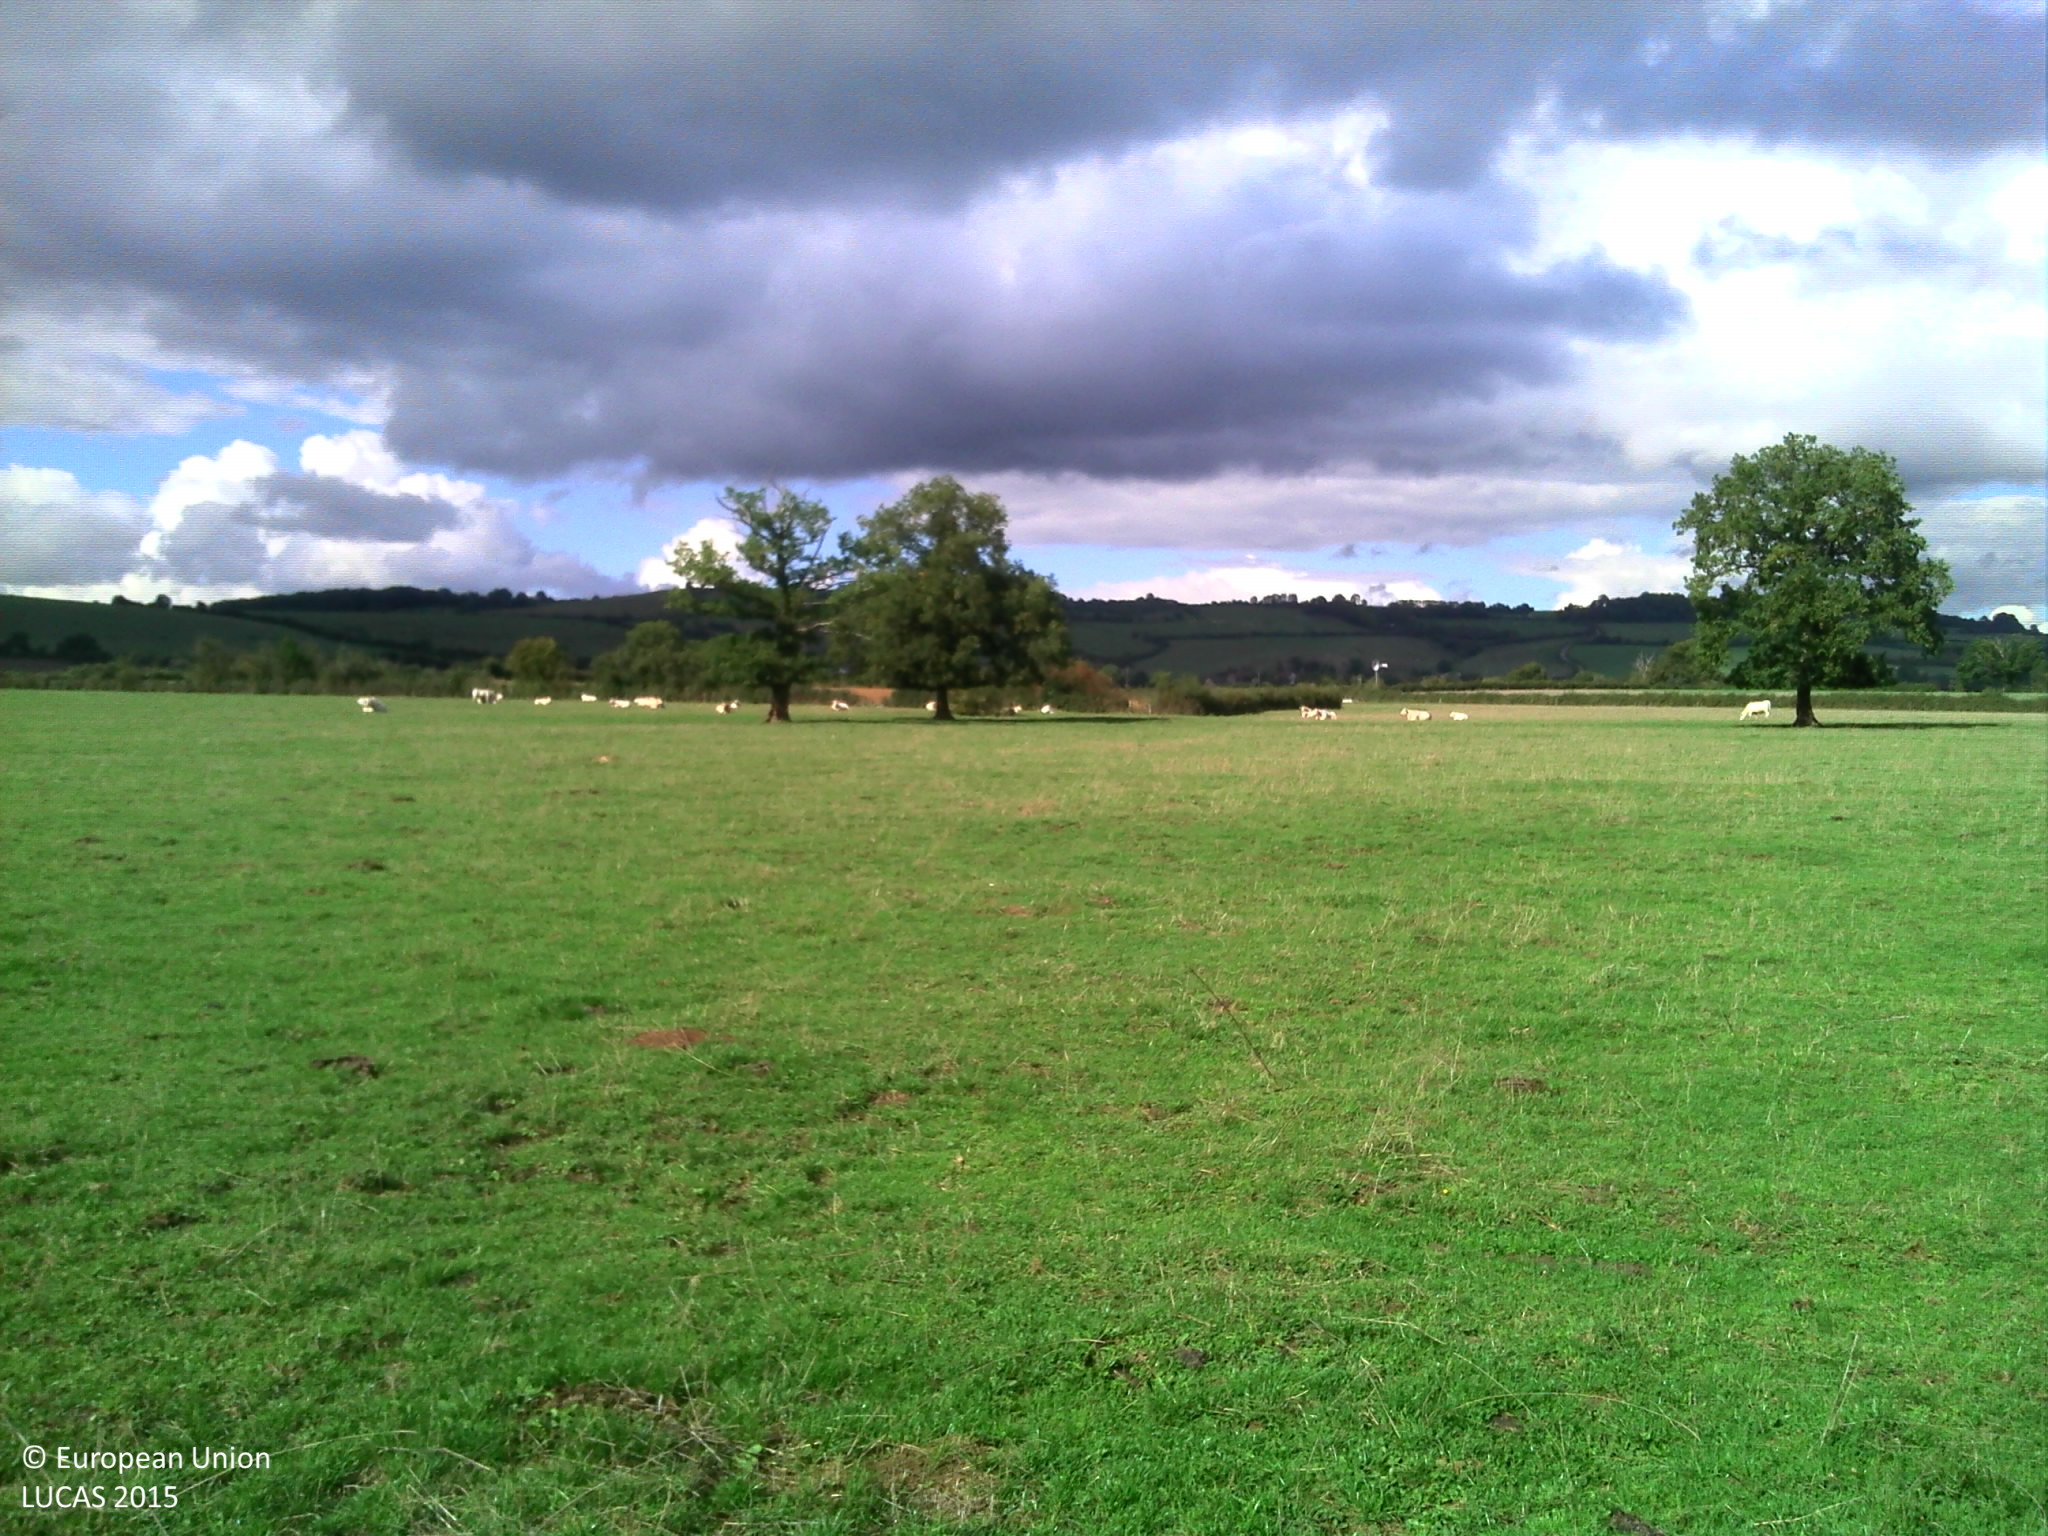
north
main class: Grassland
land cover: Grassland without tree/shrub cover
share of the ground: > 75 %
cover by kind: herbaceous plants 100 %
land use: Agriculture (excluding fallow land and kitchen gardens)
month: September
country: FR
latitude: 47.1967
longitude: 4.3897
